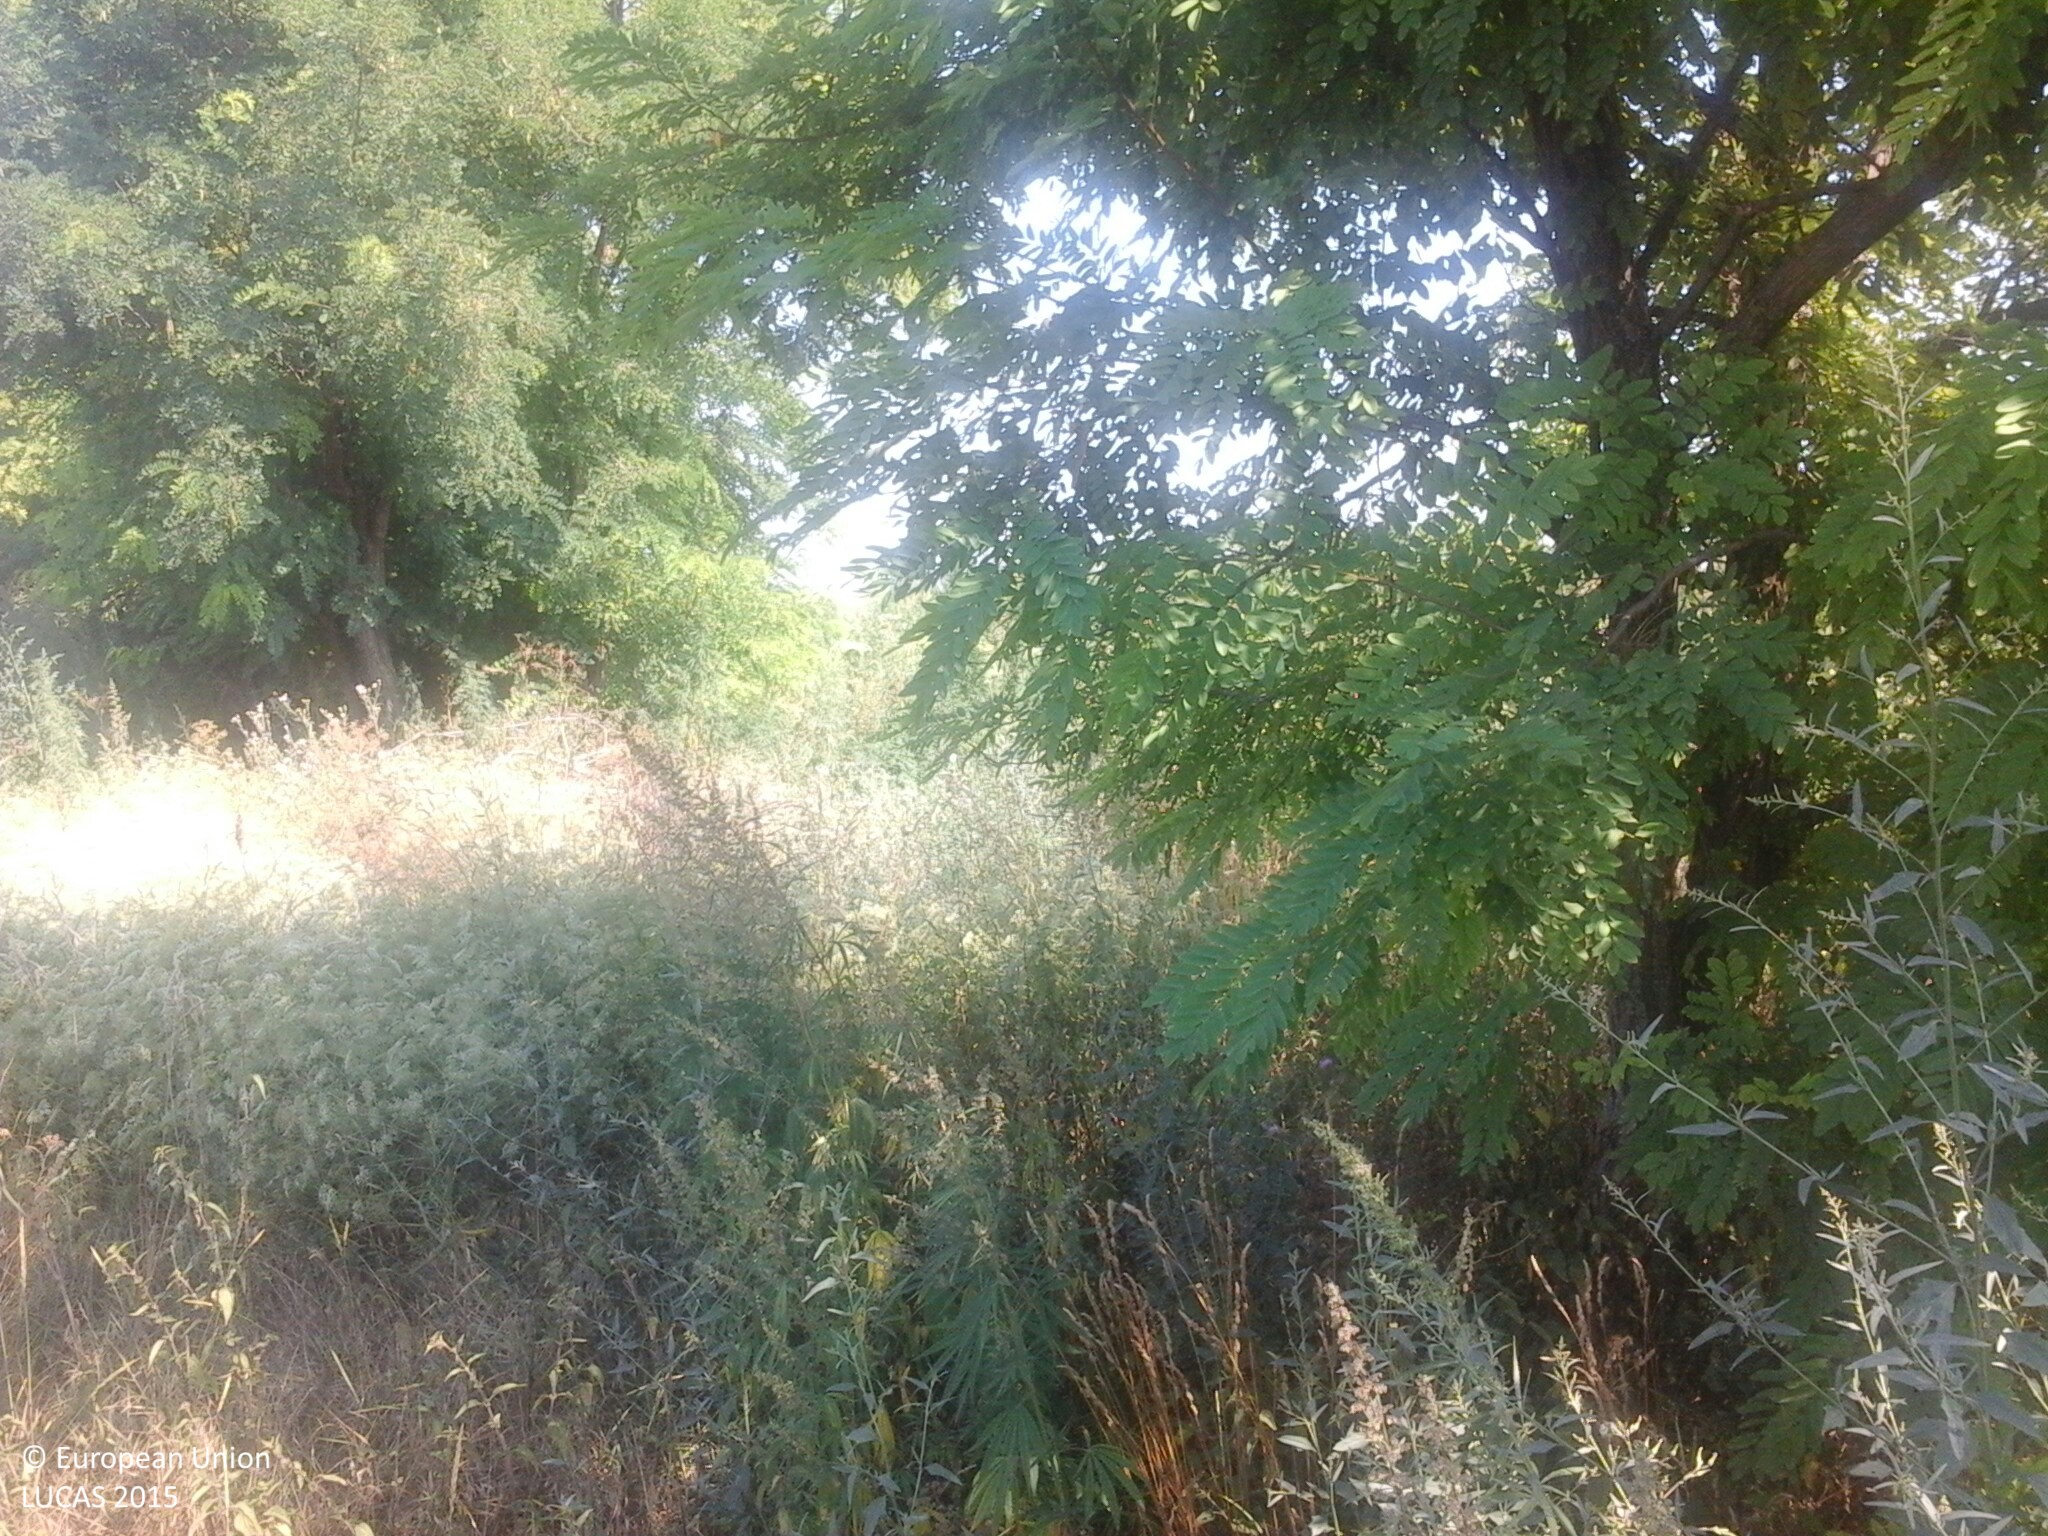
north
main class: Cropland
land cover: Sunflower
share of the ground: > 75 %
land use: Agriculture (excluding fallow land and kitchen gardens)
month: August
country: HU
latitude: 46.9390
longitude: 18.4582
